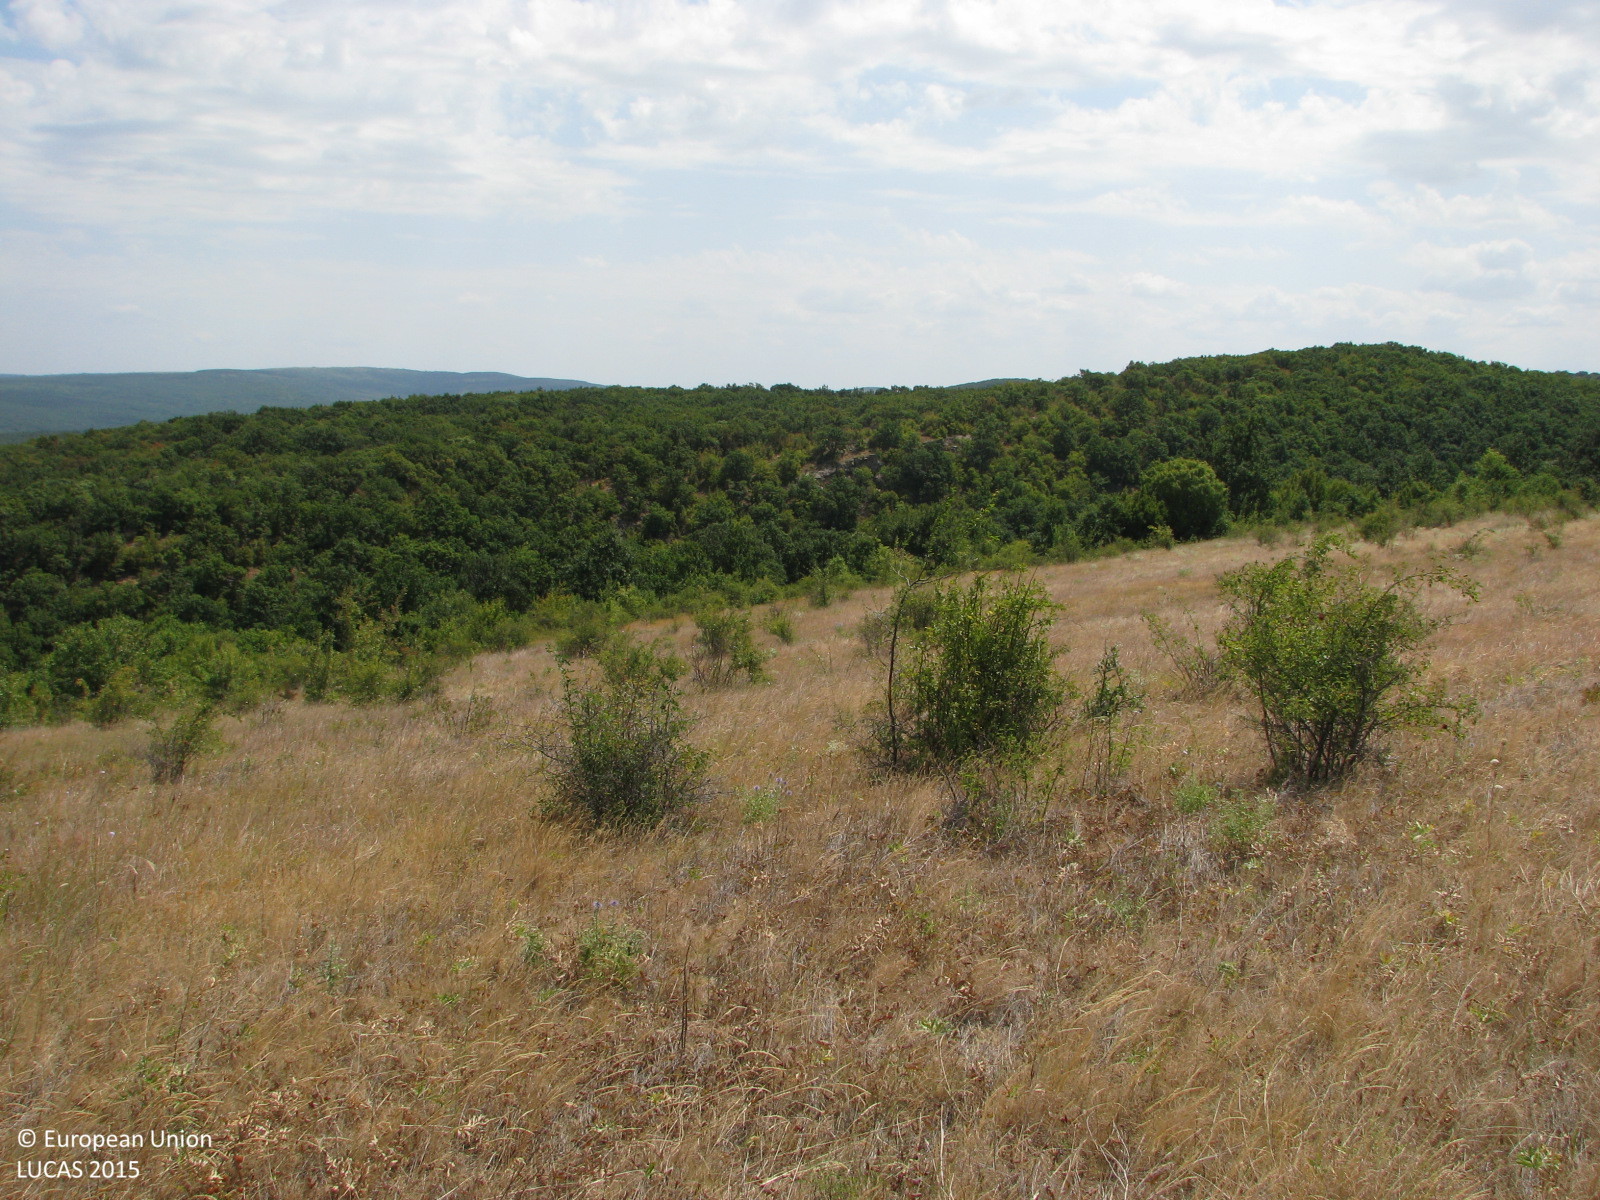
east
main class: Shrubland
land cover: Shrubland without tree cover
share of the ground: 10 - 25 %
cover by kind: herbaceous plants 80 %, shrubs 20 %
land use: Agriculture (excluding fallow land and kitchen gardens)
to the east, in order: Shrubland without tree cover; Shrubland with sparse tree cover; Ditches and canals; Broadleaved woodland
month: August
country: BG
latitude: 42.6877
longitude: 26.6109
